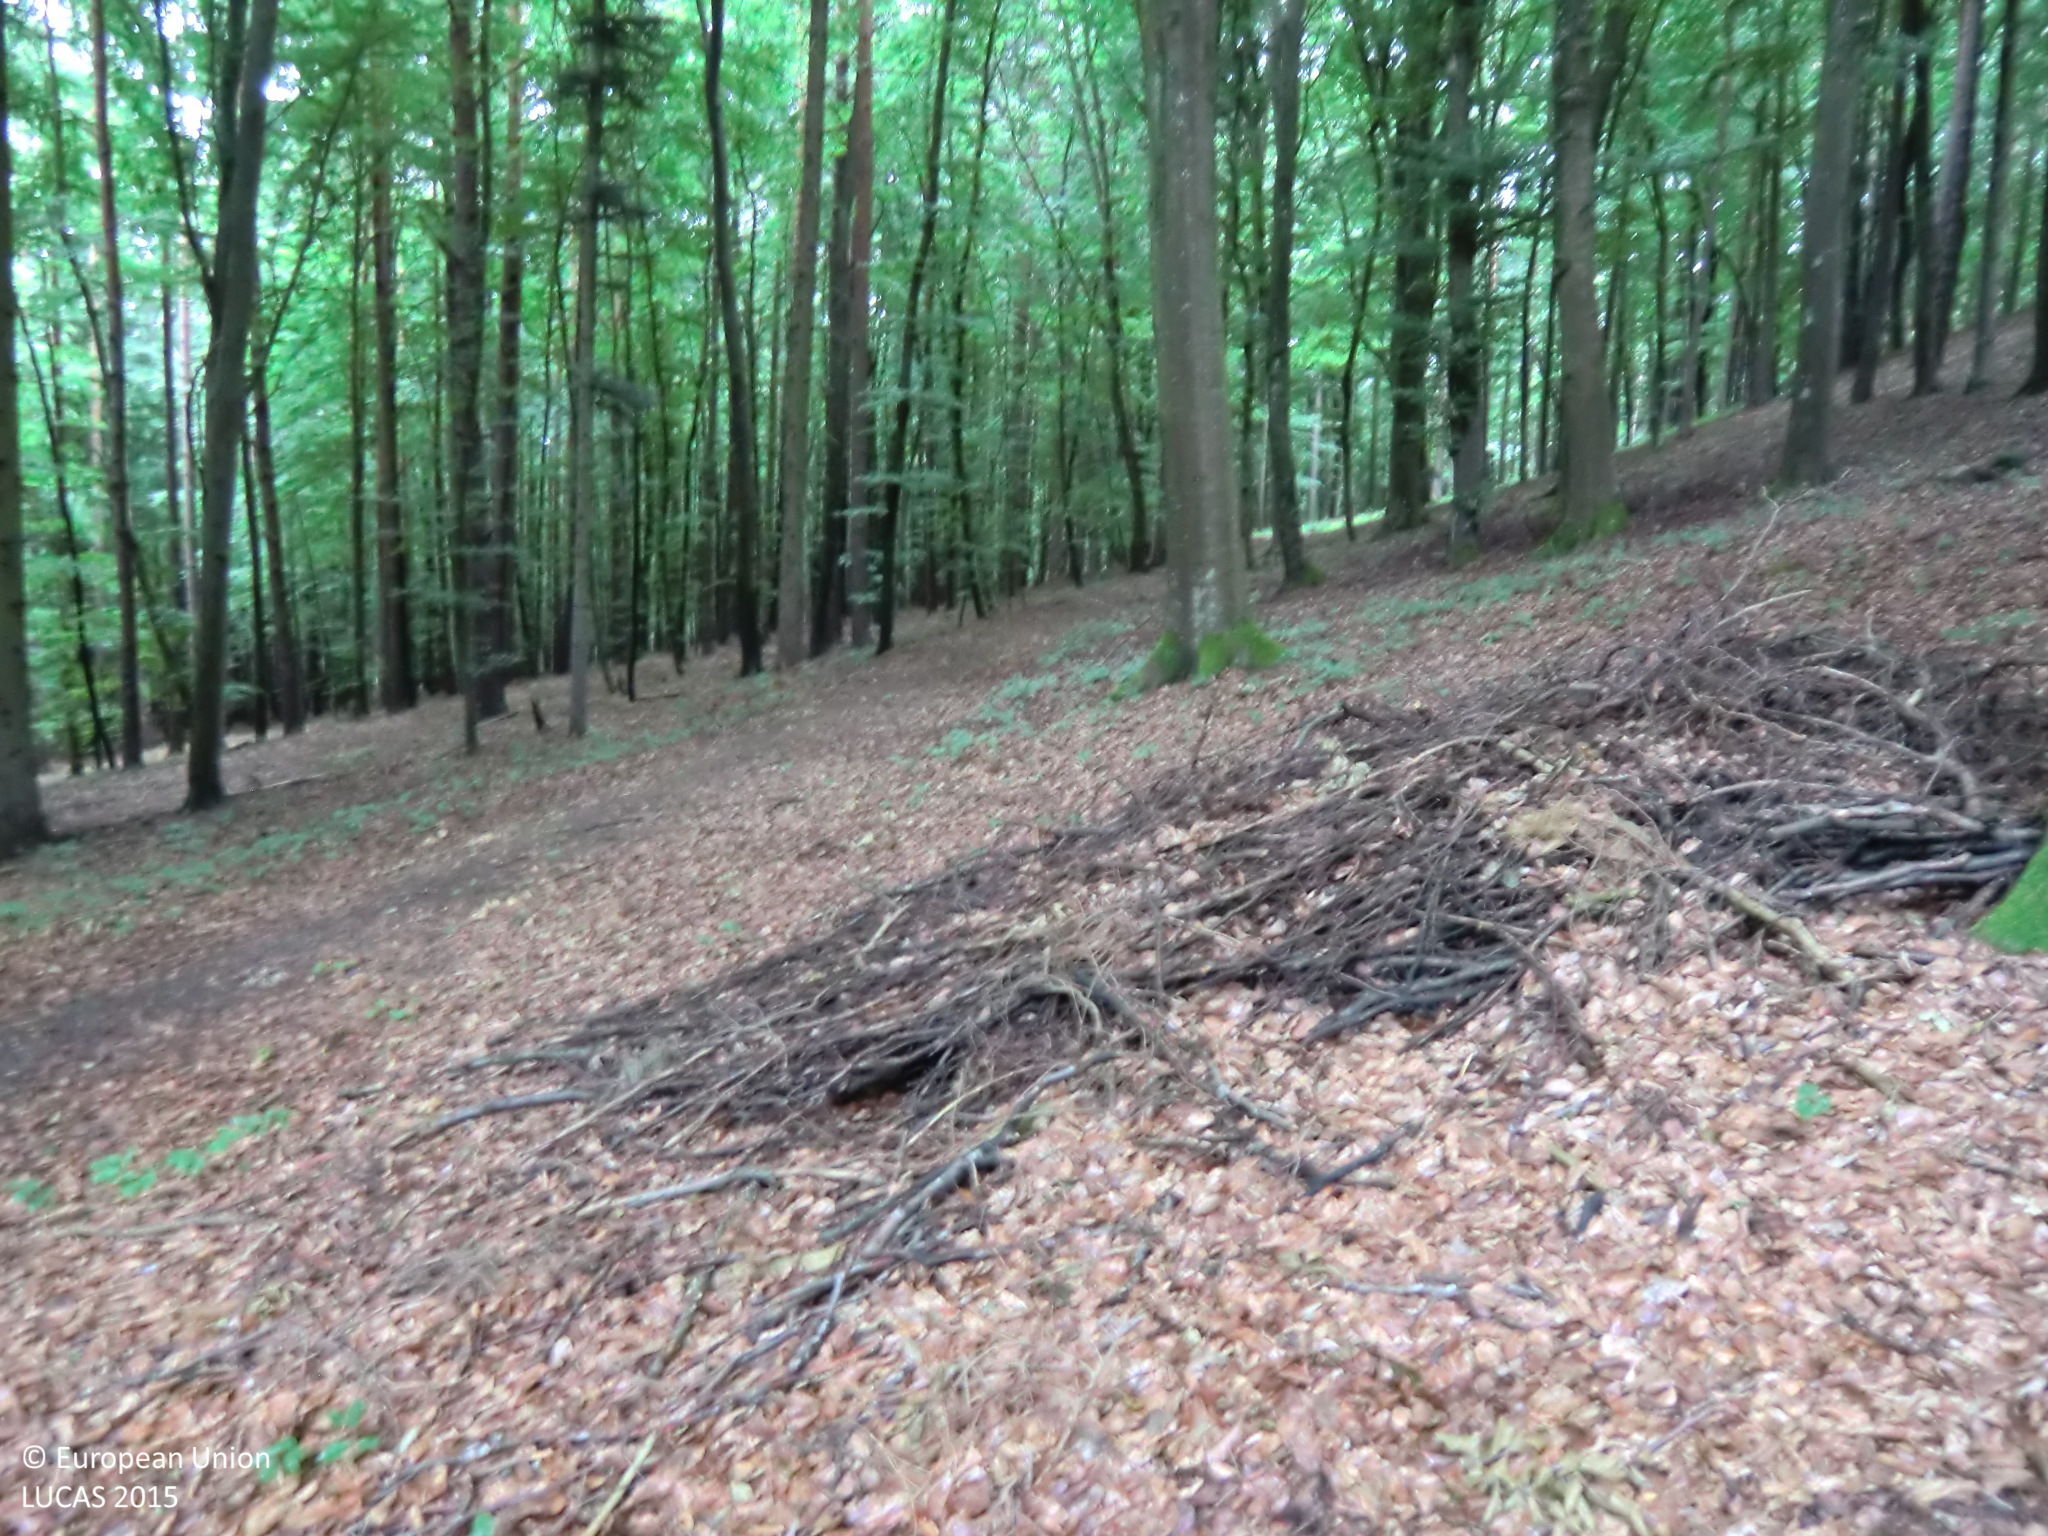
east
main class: Woodland
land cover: Pine dominated mixed woodland
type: hemiboreal forest and nemoral coniferous forest and mixed broadleaved-coniferous forest
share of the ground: > 75 %
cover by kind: broadleaved forest trees 60 %, coniferous forest trees 25 %, unconsolidated bare surface 10 %, herbaceous plants 5 %
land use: Forestry
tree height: > 5 m
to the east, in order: Pine dominated mixed woodland; Broadleaved woodland; Pine dominated mixed woodland; Tracks; Pine dominated mixed woodland; Spontaneously vegetated surfaces; Tracks; Spontaneously vegetated surfaces; Electric lines
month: June
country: AT
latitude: 47.2293
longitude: 16.0111
